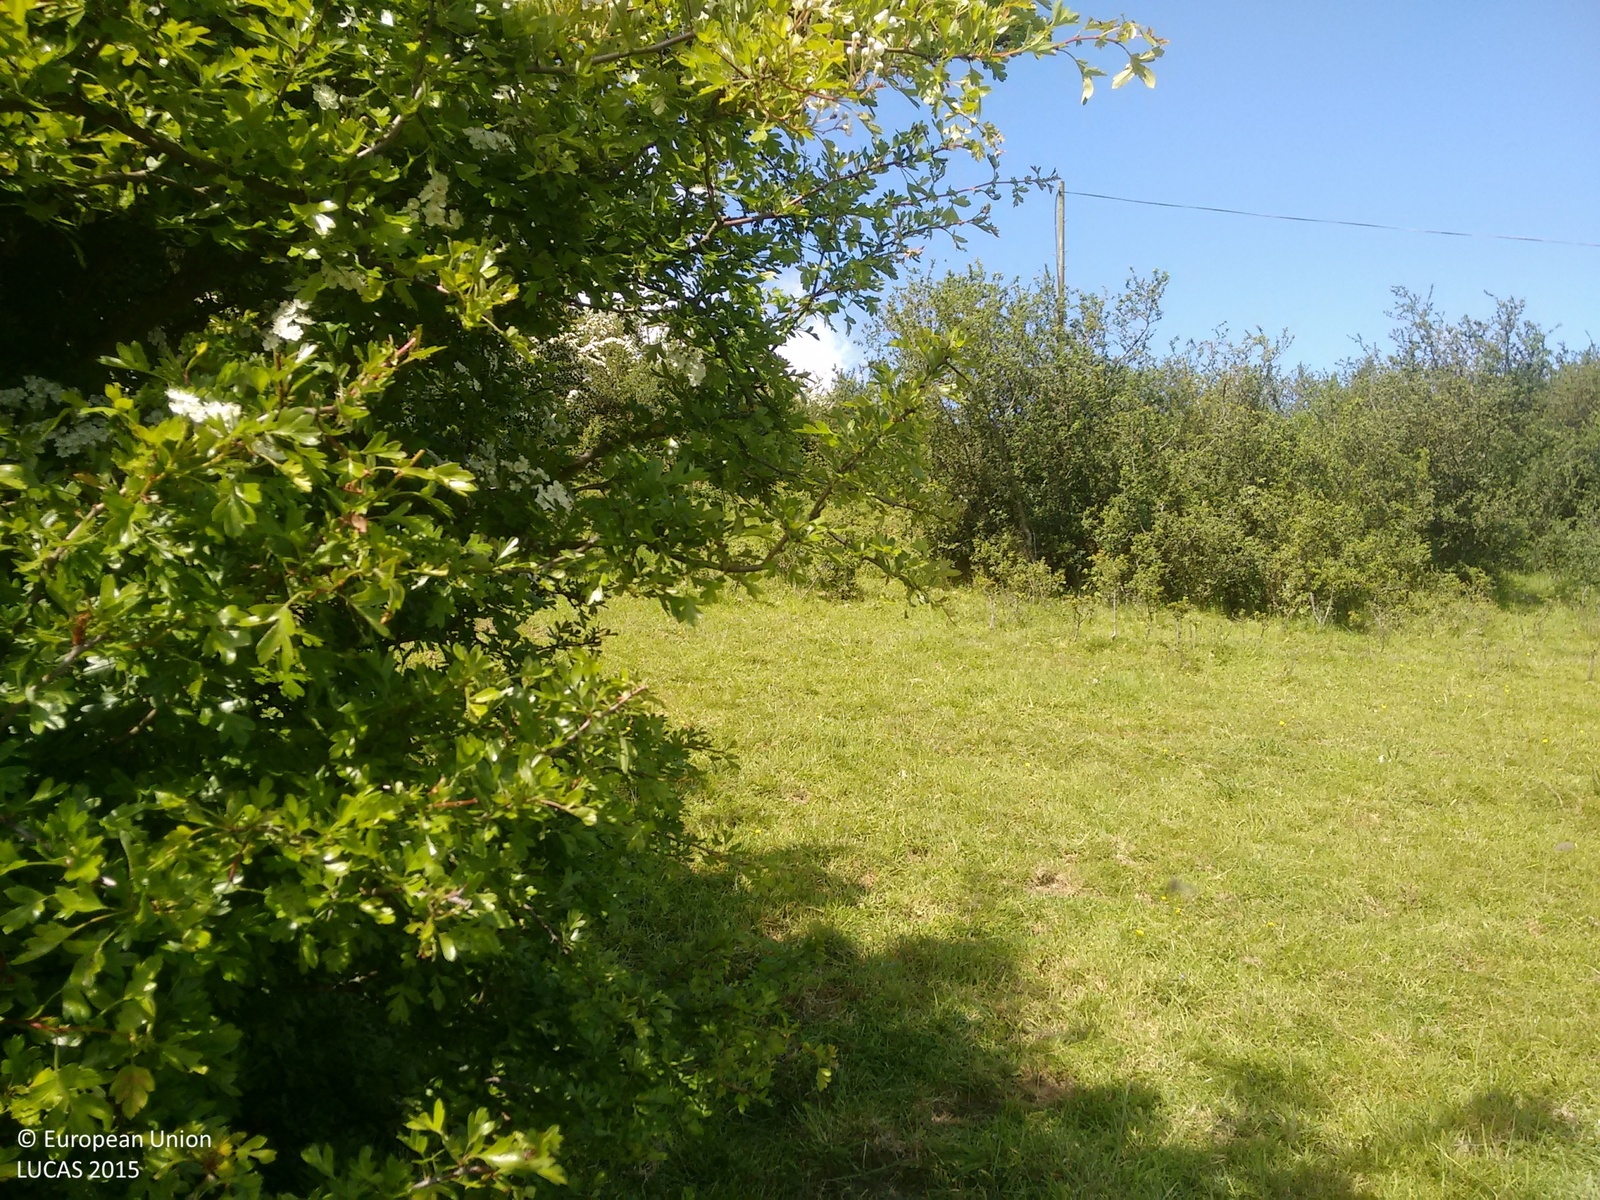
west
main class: Grassland
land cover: Grassland with sparse tree/shrub cover
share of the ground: > 75 %
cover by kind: herbaceous plants 85 %, shrubs 10 %, broadleaved forest trees 5 %
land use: Amenities, museums, leisure
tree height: < 5 m
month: May
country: GB
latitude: 51.0849
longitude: 1.1123
